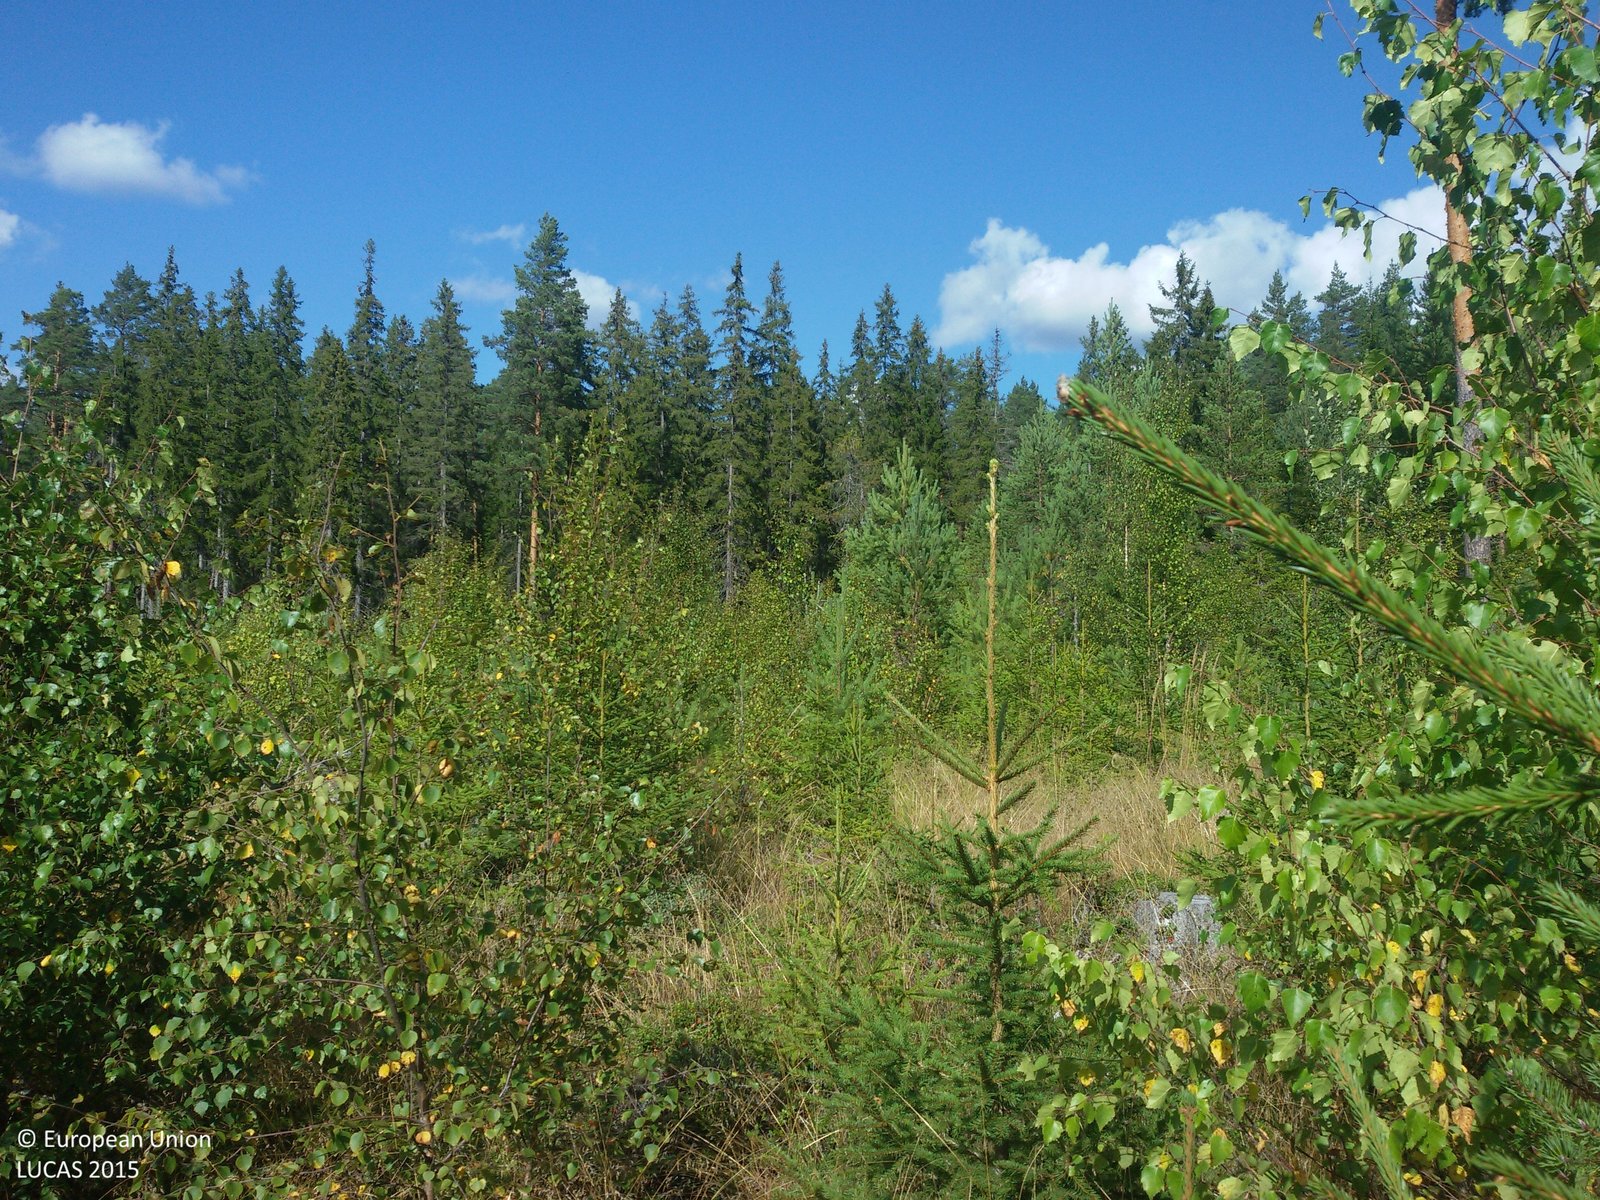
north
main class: Woodland
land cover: Spruce dominated mixed woodland
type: boreal forest
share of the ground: 50 - 75 %
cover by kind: herbaceous plants 45 %, coniferous forest trees 35 %, broadleaved forest trees 20 %
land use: Forestry
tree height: < 5 m
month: August
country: SE
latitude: 60.6637
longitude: 15.6412
